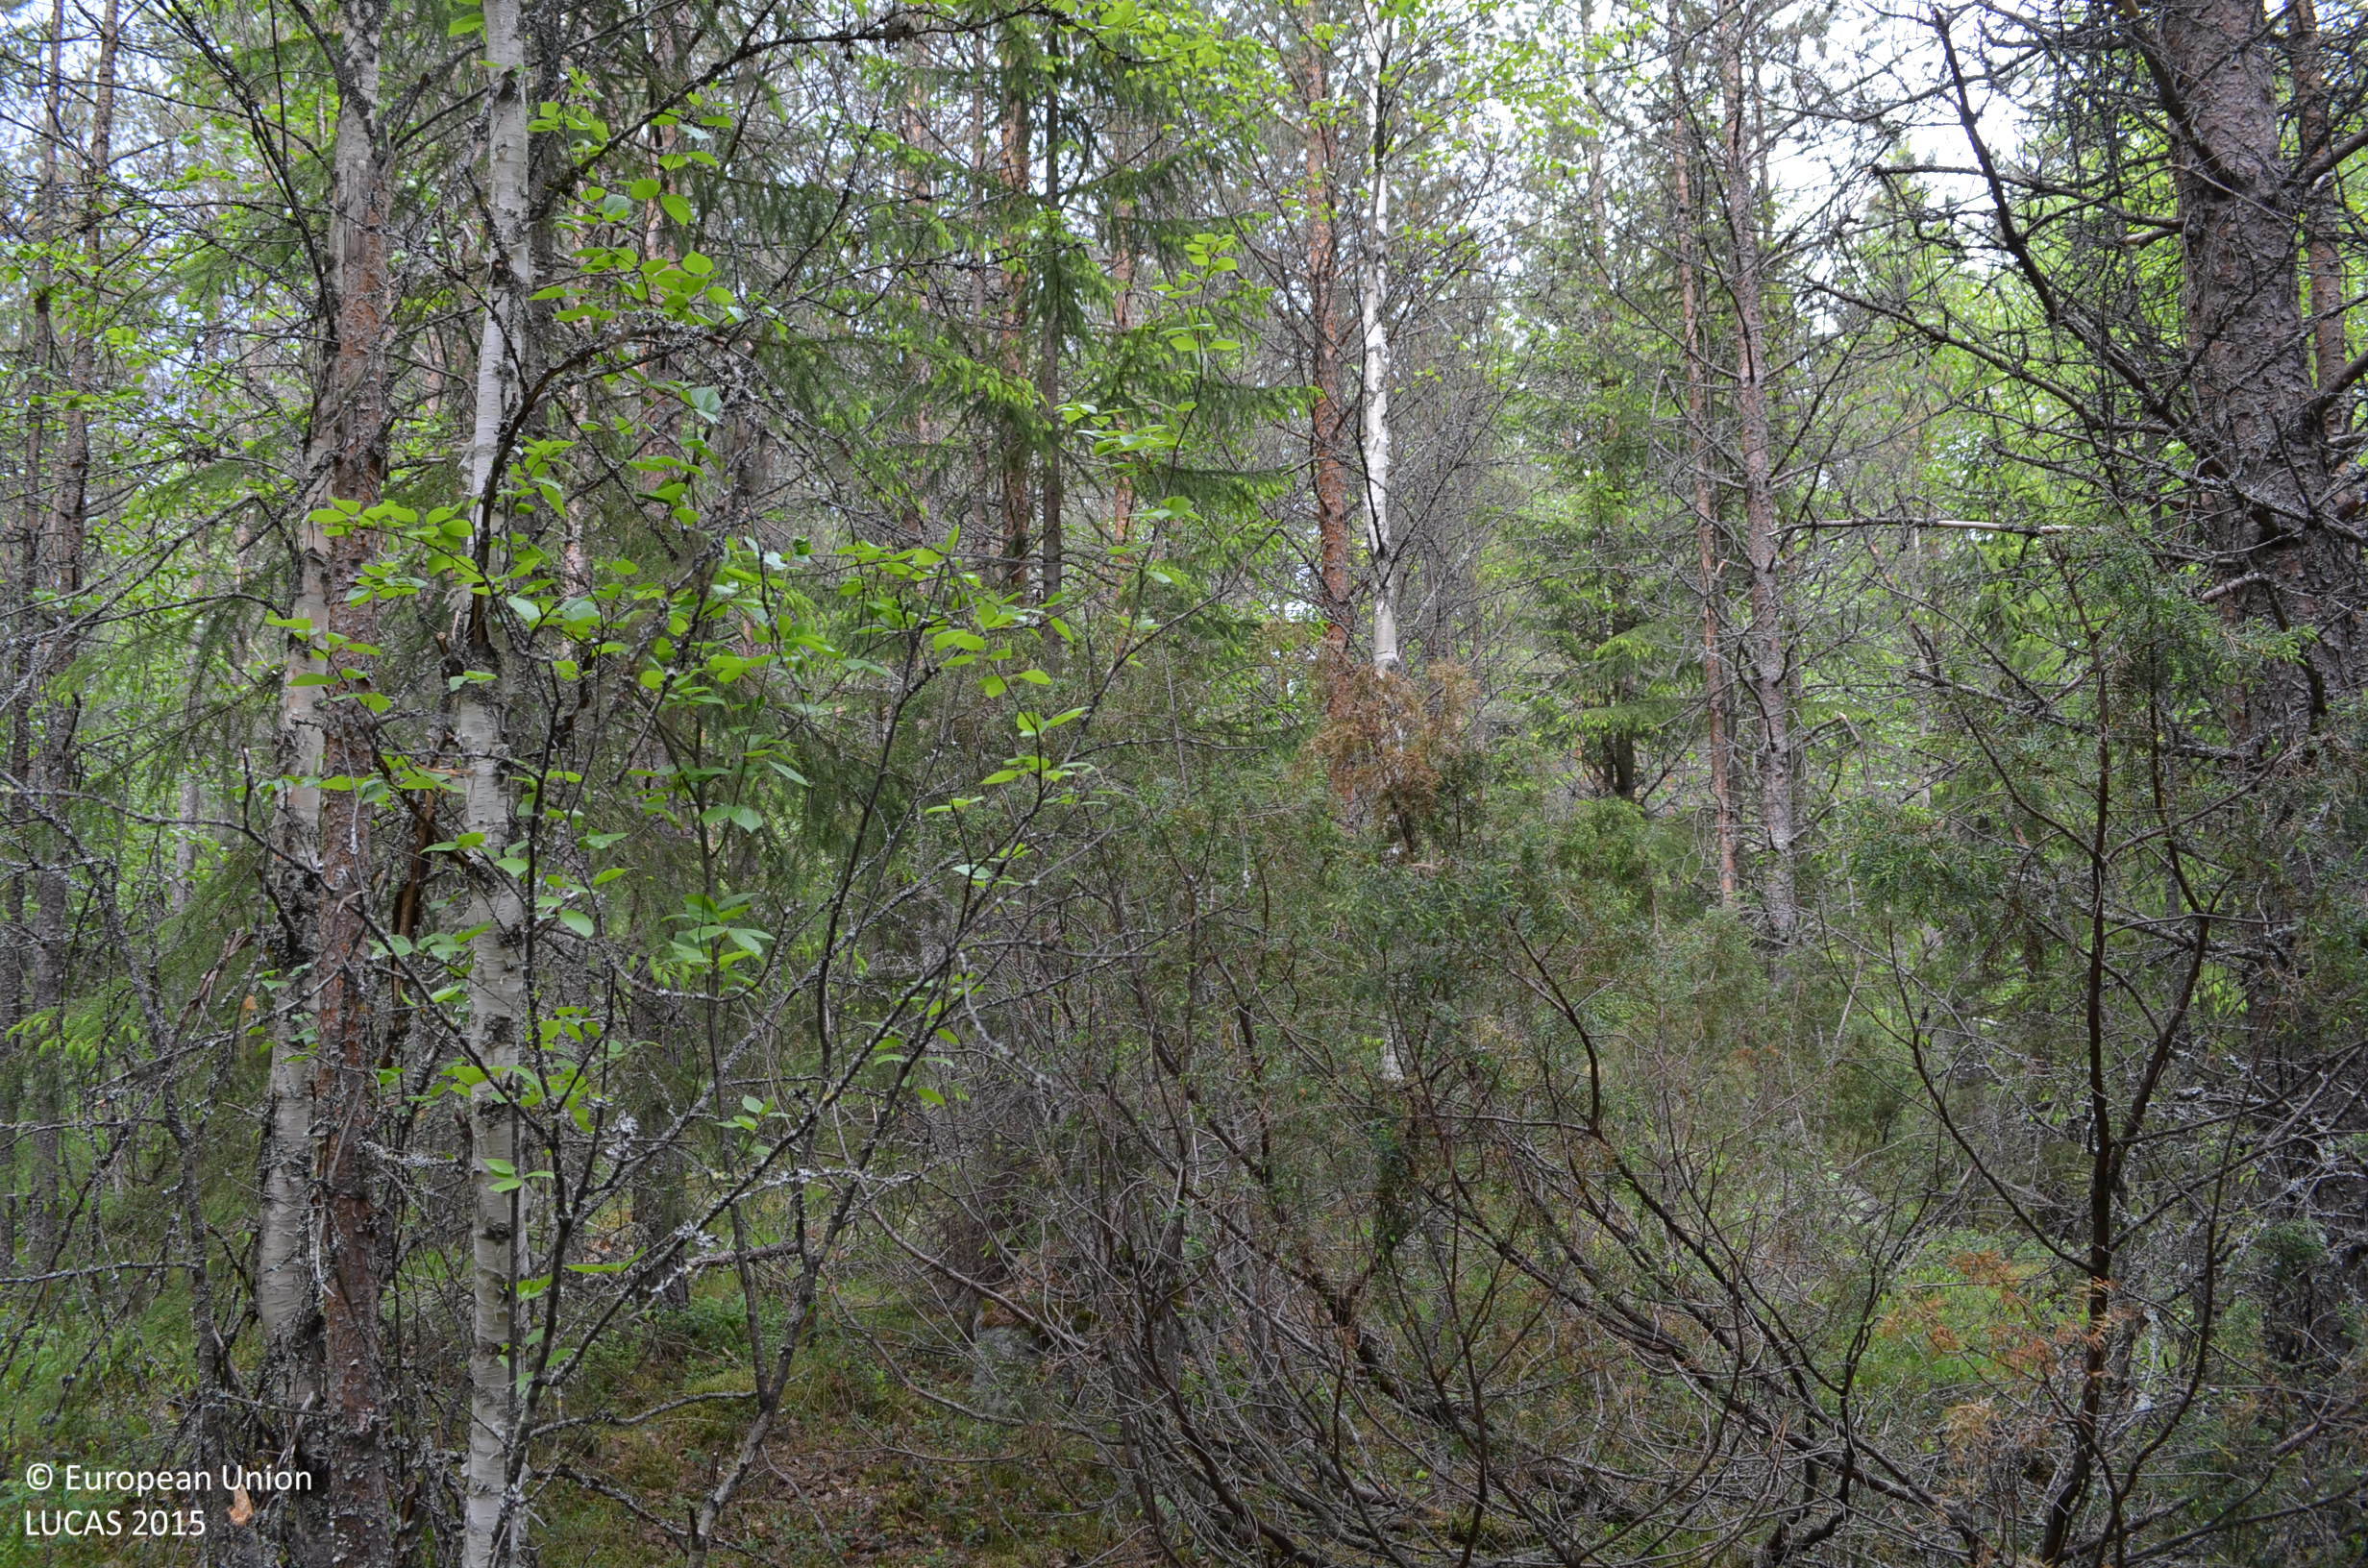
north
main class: Woodland
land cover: Other mixed woodland
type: boreal forest
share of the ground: > 75 %
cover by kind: coniferous forest trees 65 %, broadleaved forest trees 25 %, shrubs 5 %, herbaceous plants 5 %
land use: Forestry
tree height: > 5 m
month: June
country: FI
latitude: 61.9650
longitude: 23.2889
